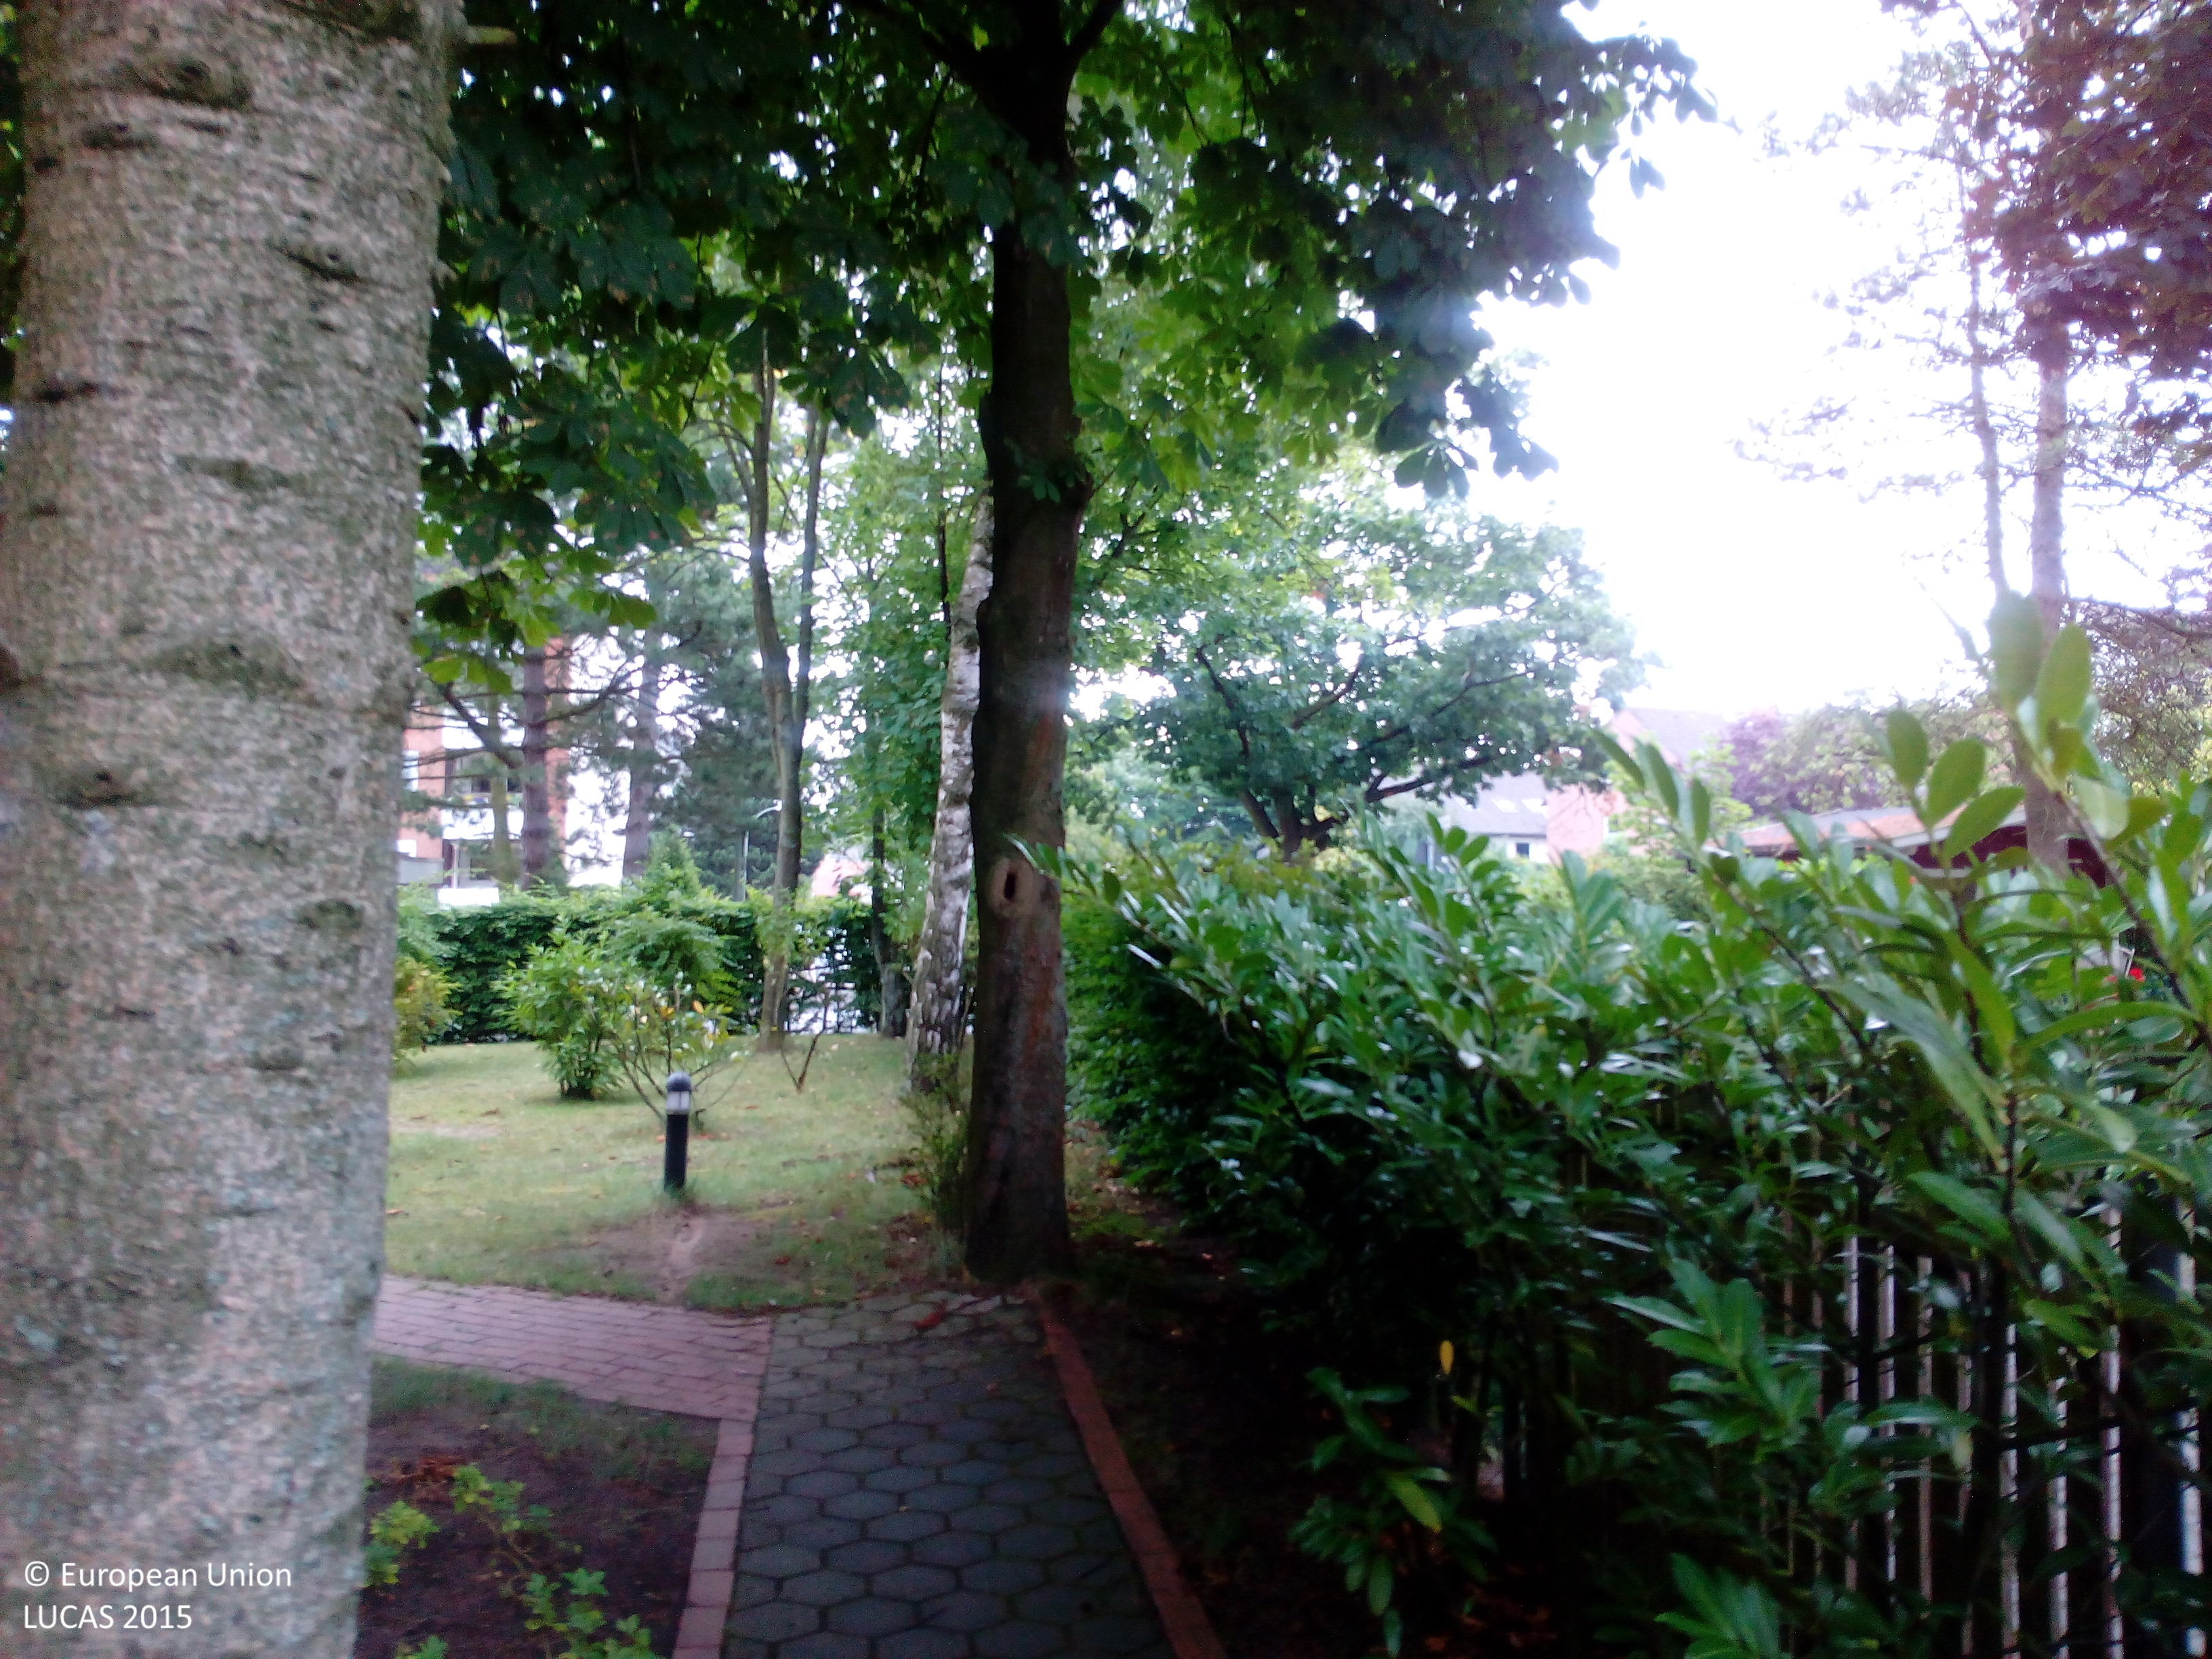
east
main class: Cropland
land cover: Floriculture and ornamental plants
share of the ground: 50 - 75 %
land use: Residential
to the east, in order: Floriculture and ornamental plants; Artificial constructions in urban areas
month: July
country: DE
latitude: 52.2711
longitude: 8.0221
